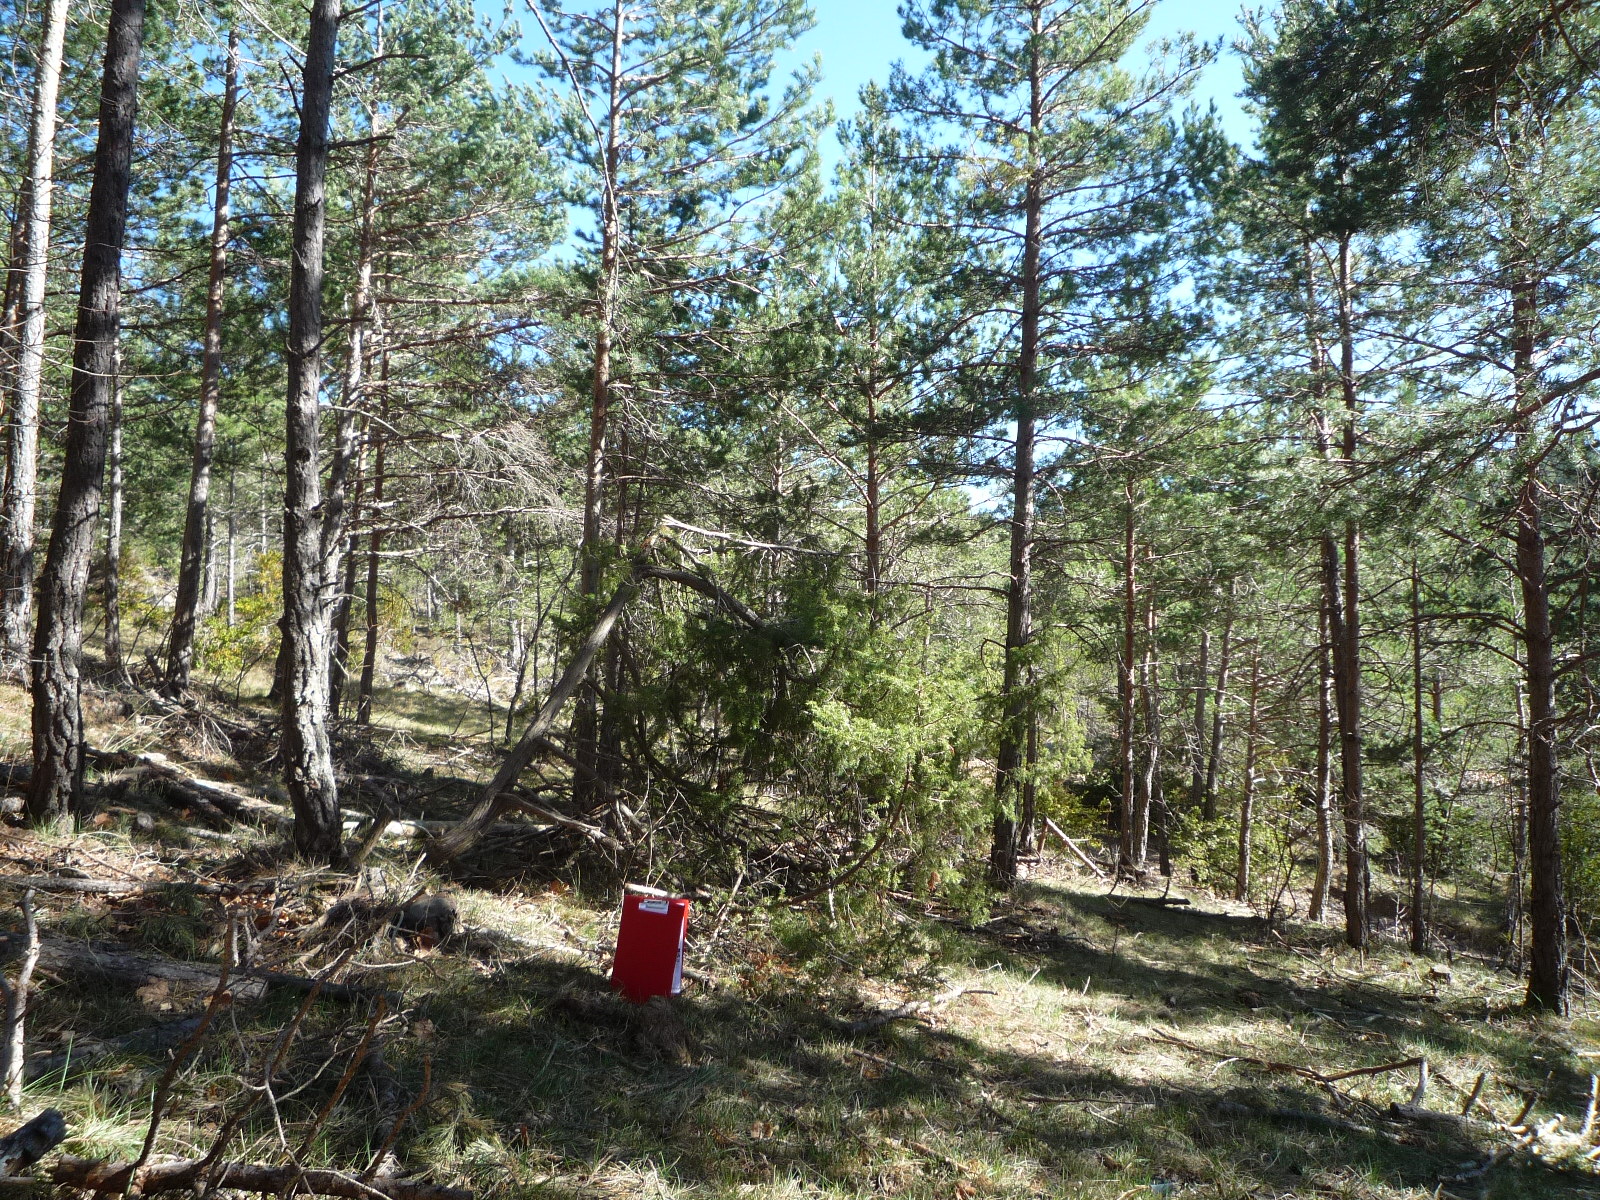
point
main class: Woodland
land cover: Pine dominated coniferous woodland
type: coniferous forest of the mediterranean region
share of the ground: > 75 %
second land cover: Spontaneously vegetated surfaces
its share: 25 - 50 %
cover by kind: coniferous forest trees 75 %, herbaceous plants 25 %
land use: Forestry
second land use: Agriculture (excluding fallow land and kitchen gardens)
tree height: > 5 m
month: March
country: ES
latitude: 42.0896
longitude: 1.6341
